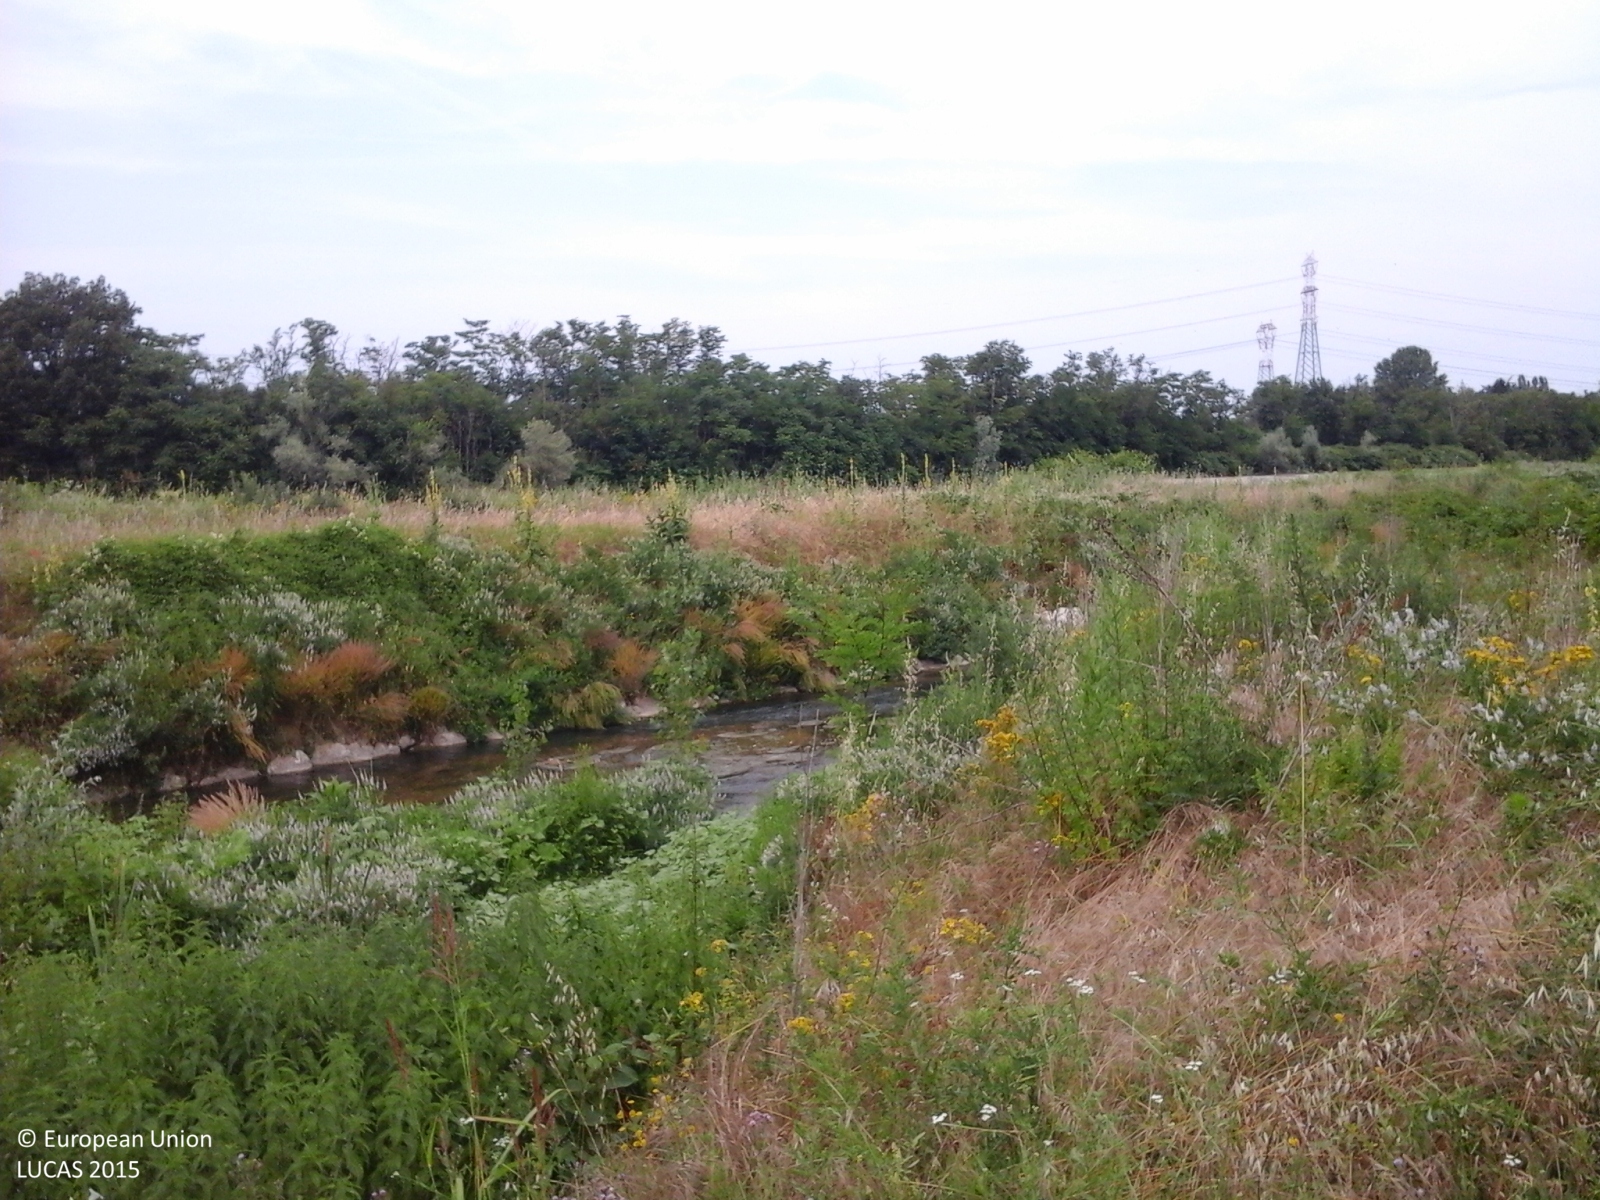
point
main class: Woodland
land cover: Broadleaved woodland
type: thermophilous deciduous forest
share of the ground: > 75 %
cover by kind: broadleaved forest trees 100 %
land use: Semi-natural and natural areas not in use
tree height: > 5 m
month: June
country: IT
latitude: 44.7649
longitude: 10.2900
